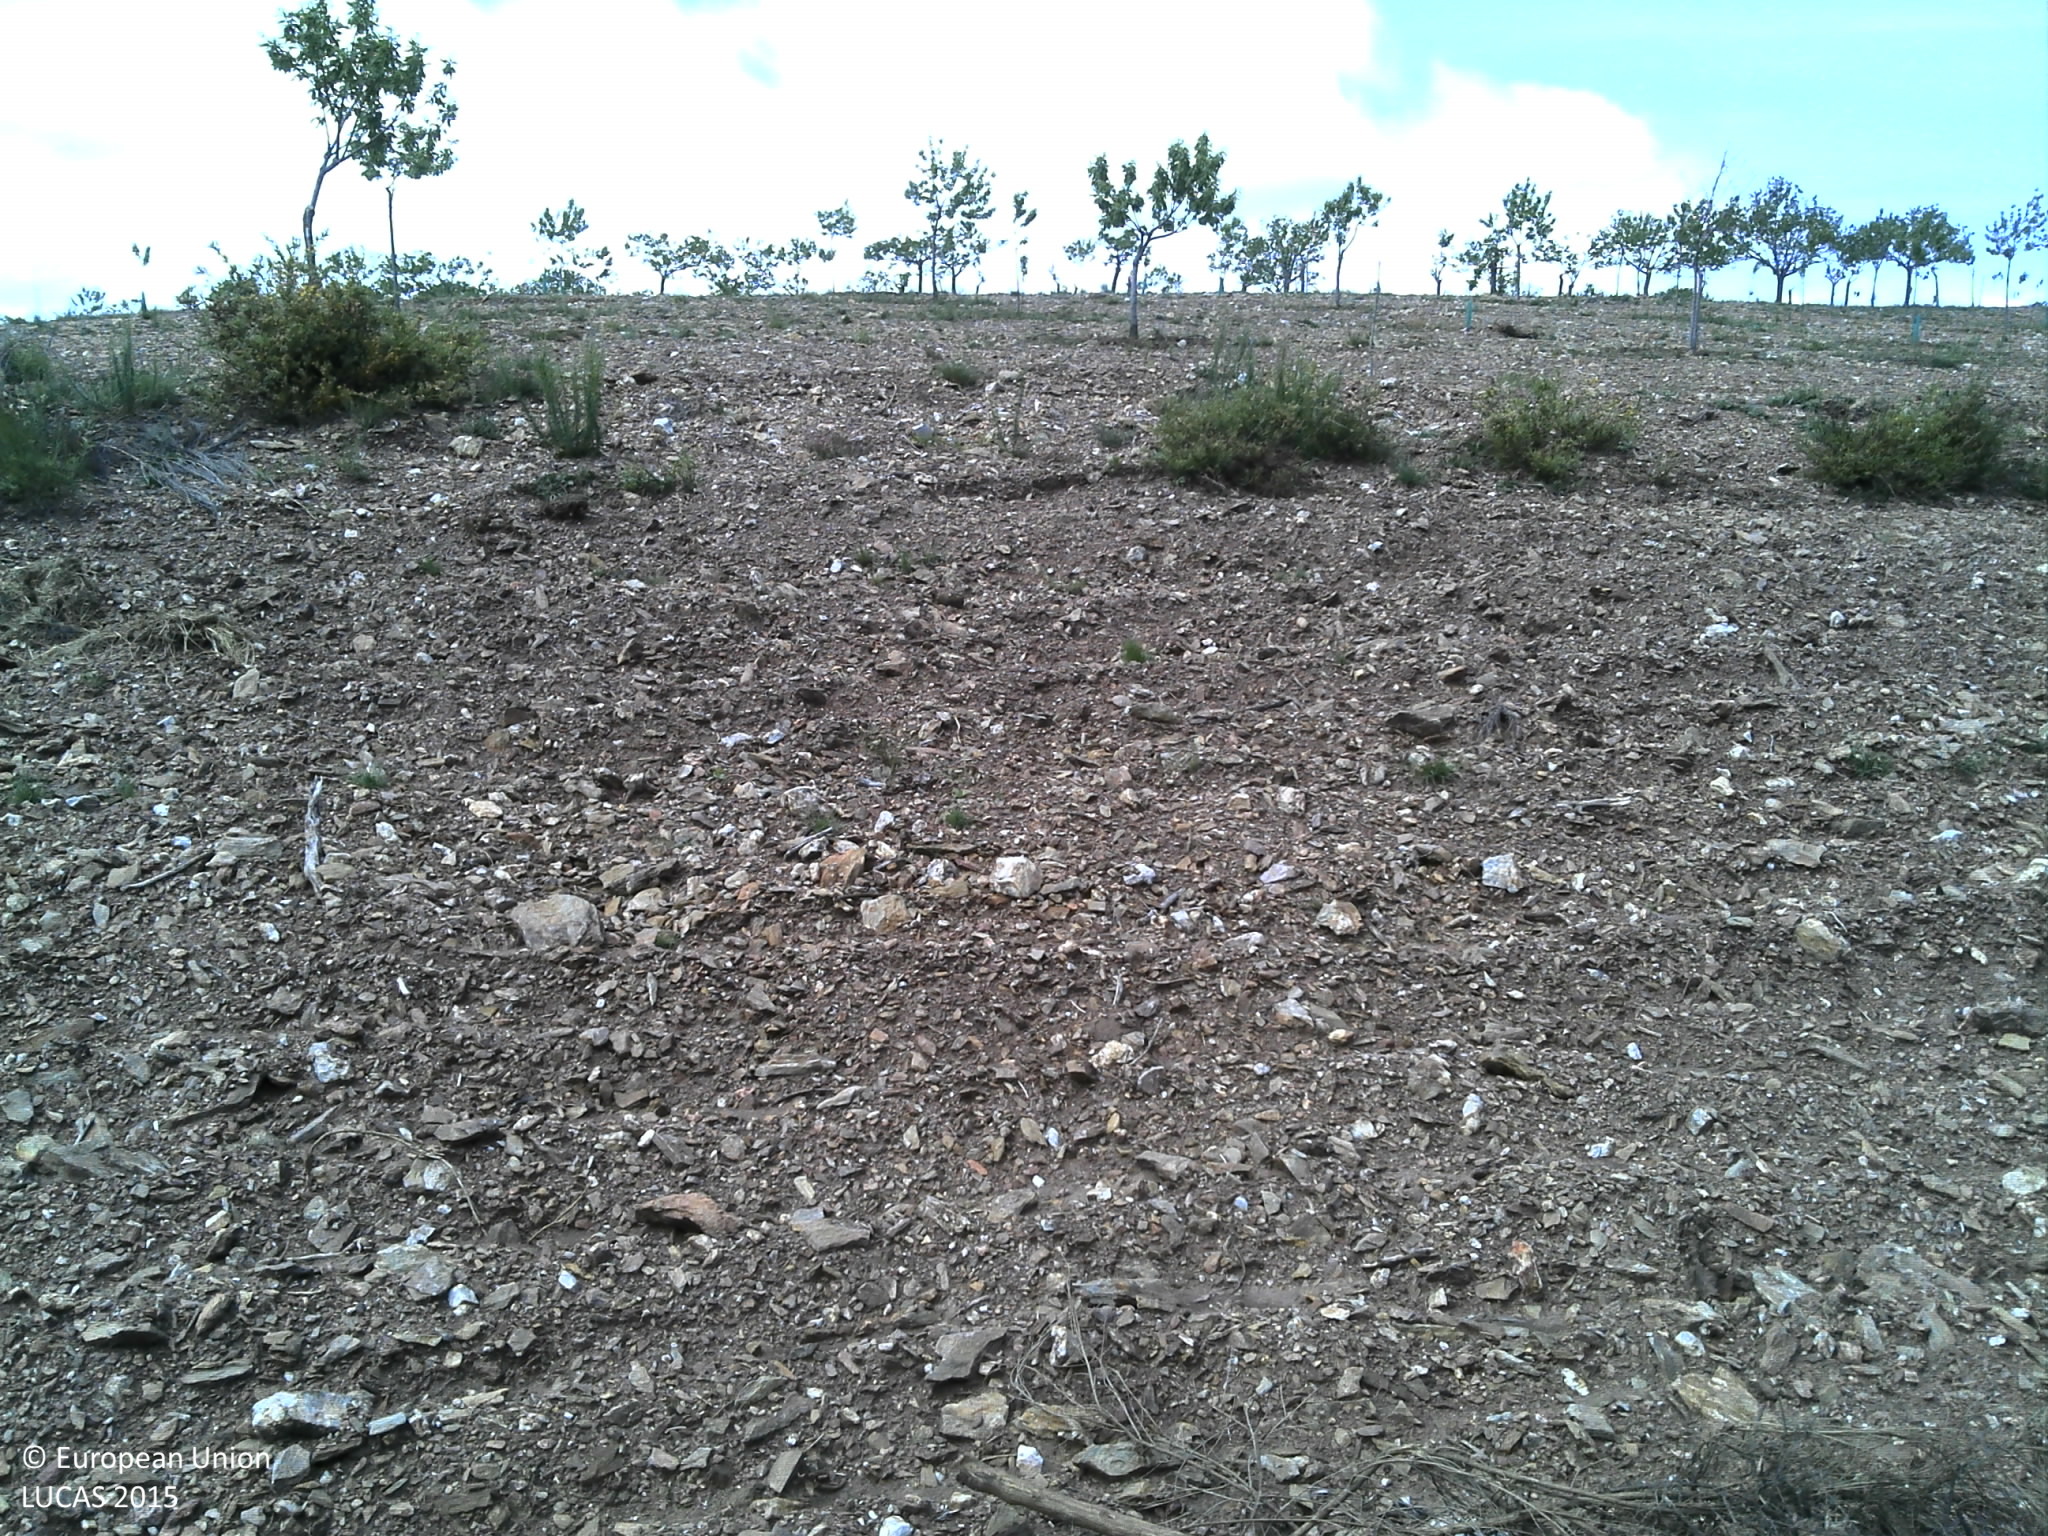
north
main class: Cropland
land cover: Nuts trees
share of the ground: < 10 %
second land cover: Other bare soil
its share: > 75 %
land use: Agriculture (excluding fallow land and kitchen gardens)
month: May
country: PT
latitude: 41.5410
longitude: -7.4970
